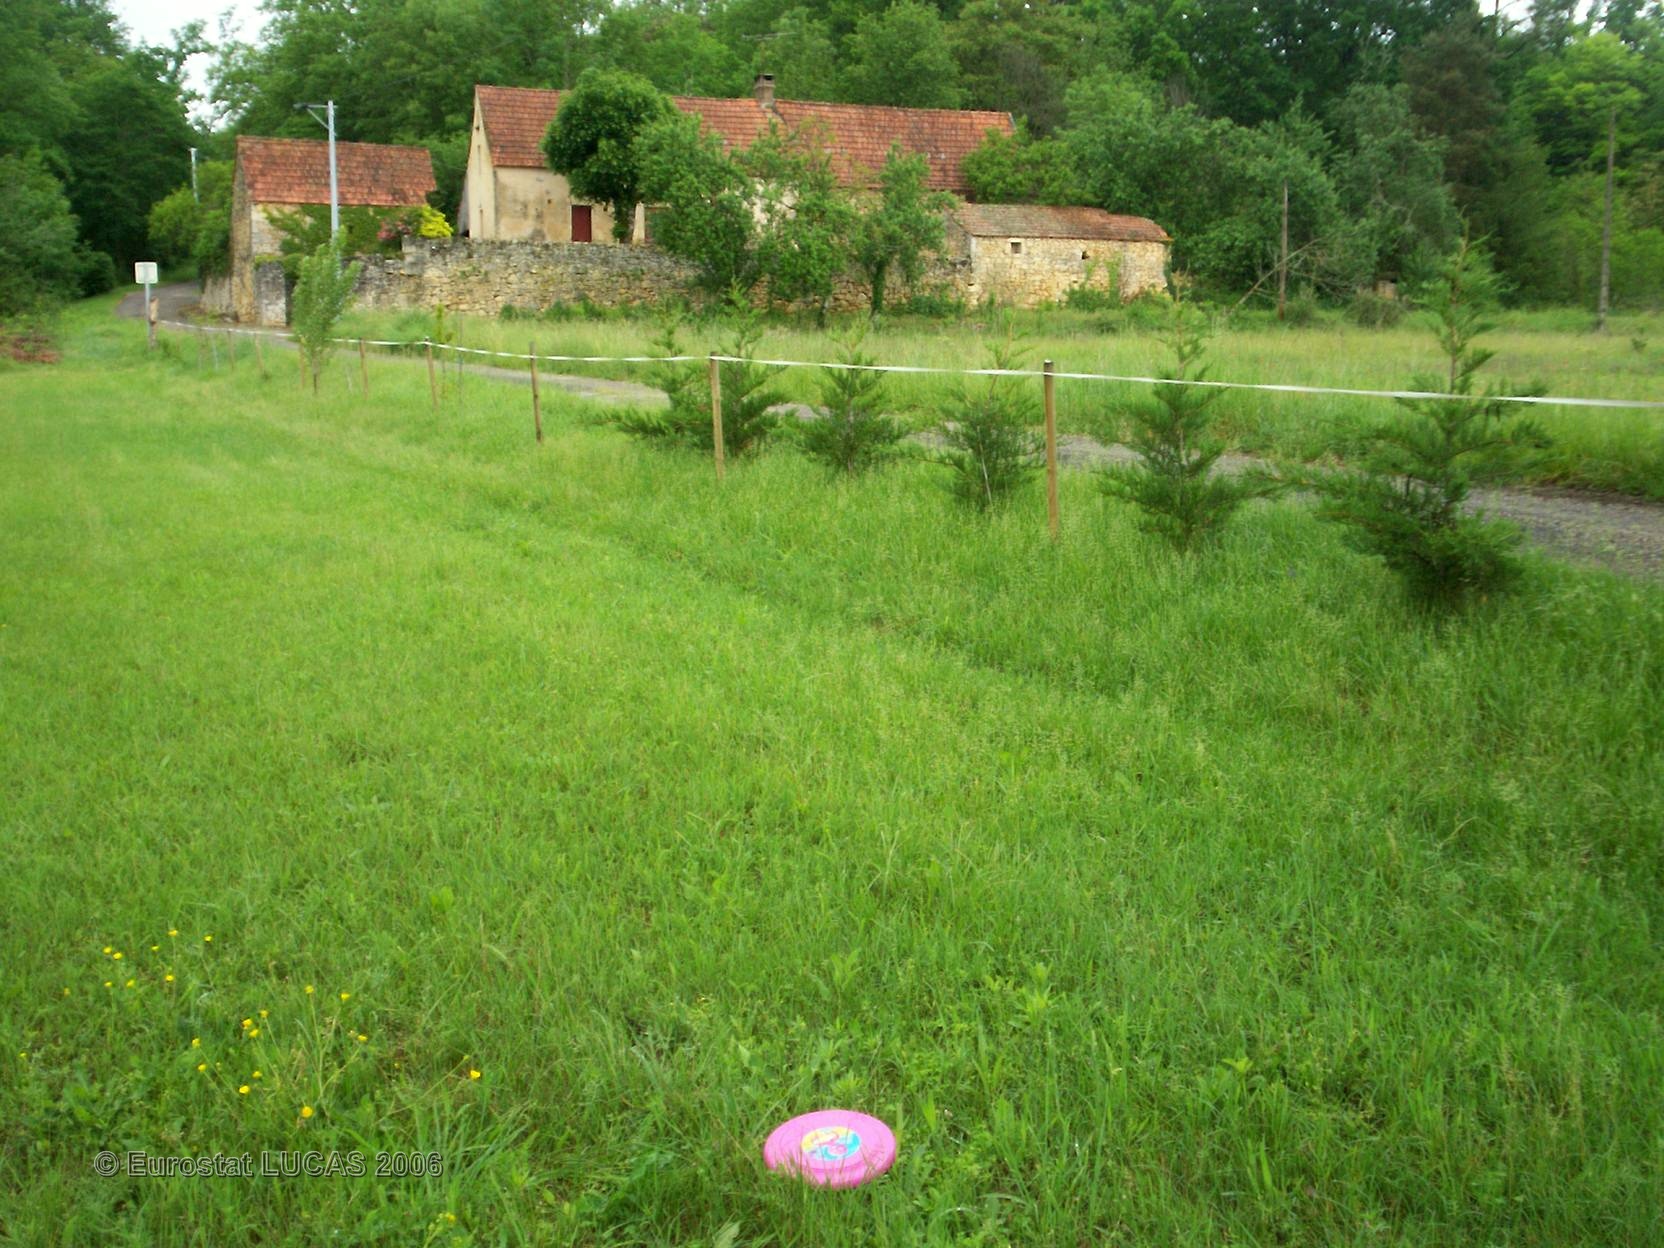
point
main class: Grassland
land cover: Grassland without tree/shrub cover
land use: Agriculture (excluding fallow land and kitchen gardens)
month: May
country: FR
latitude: 44.7876
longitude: 1.3635
